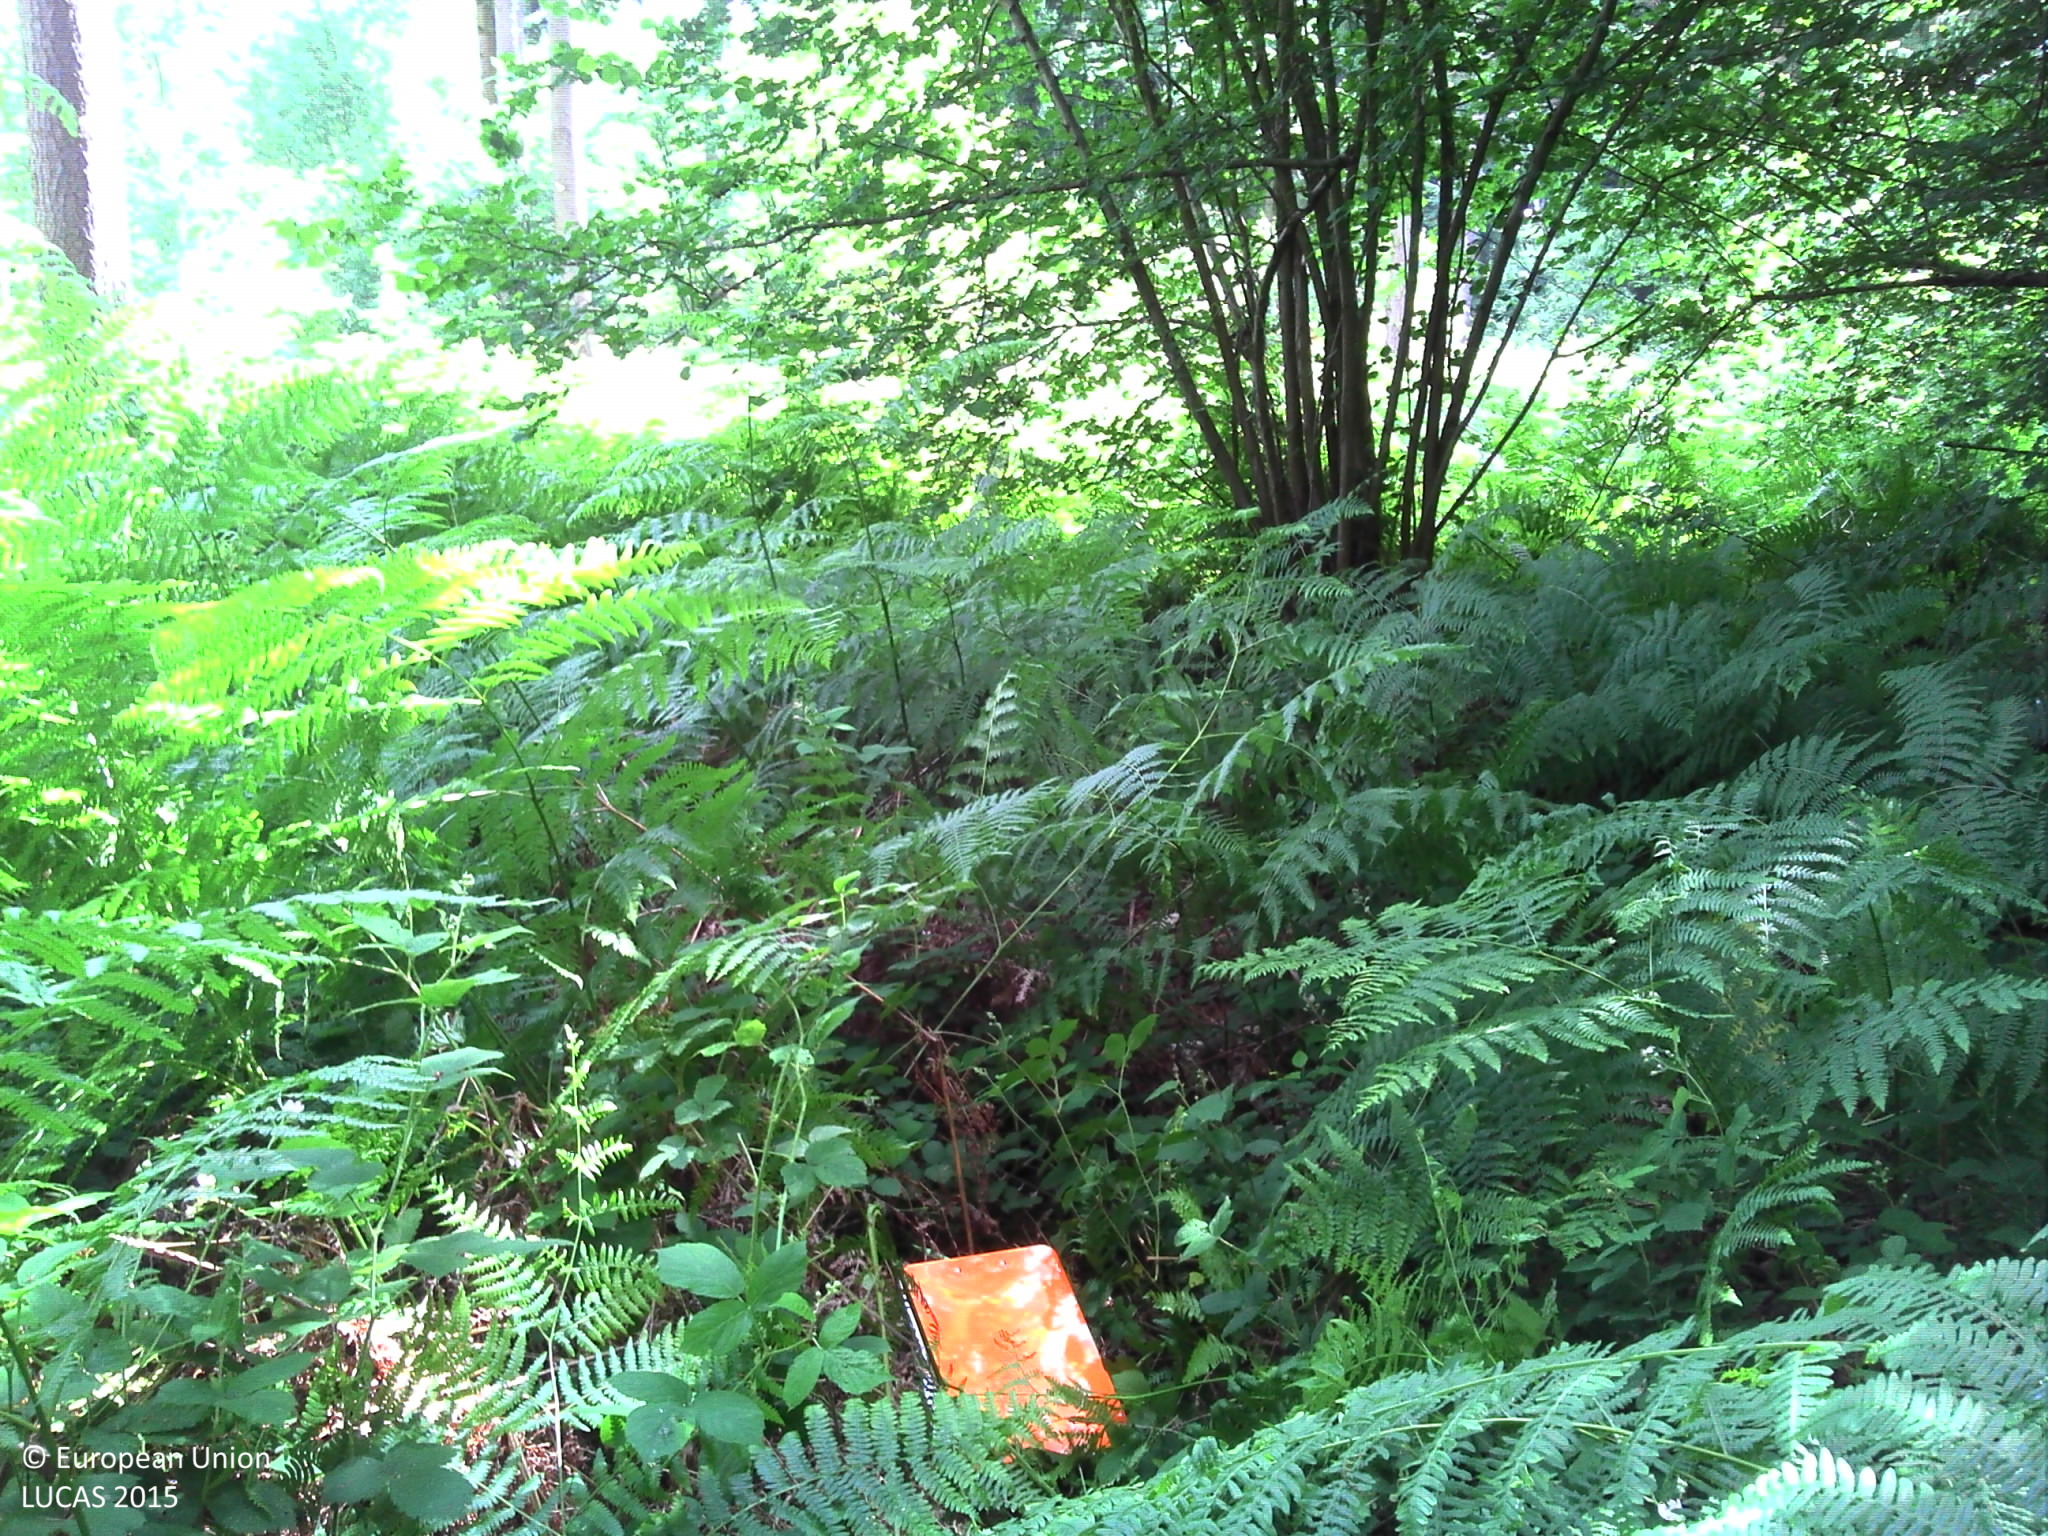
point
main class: Woodland
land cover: Spruce dominated mixed woodland
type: mesophytic deciduous forest
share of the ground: > 75 %
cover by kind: broadleaved forest trees 50 %, coniferous forest trees 40 %, herbaceous plants 10 %
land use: Forestry
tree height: > 5 m
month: June
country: FR
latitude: 49.2422
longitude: 1.1471
